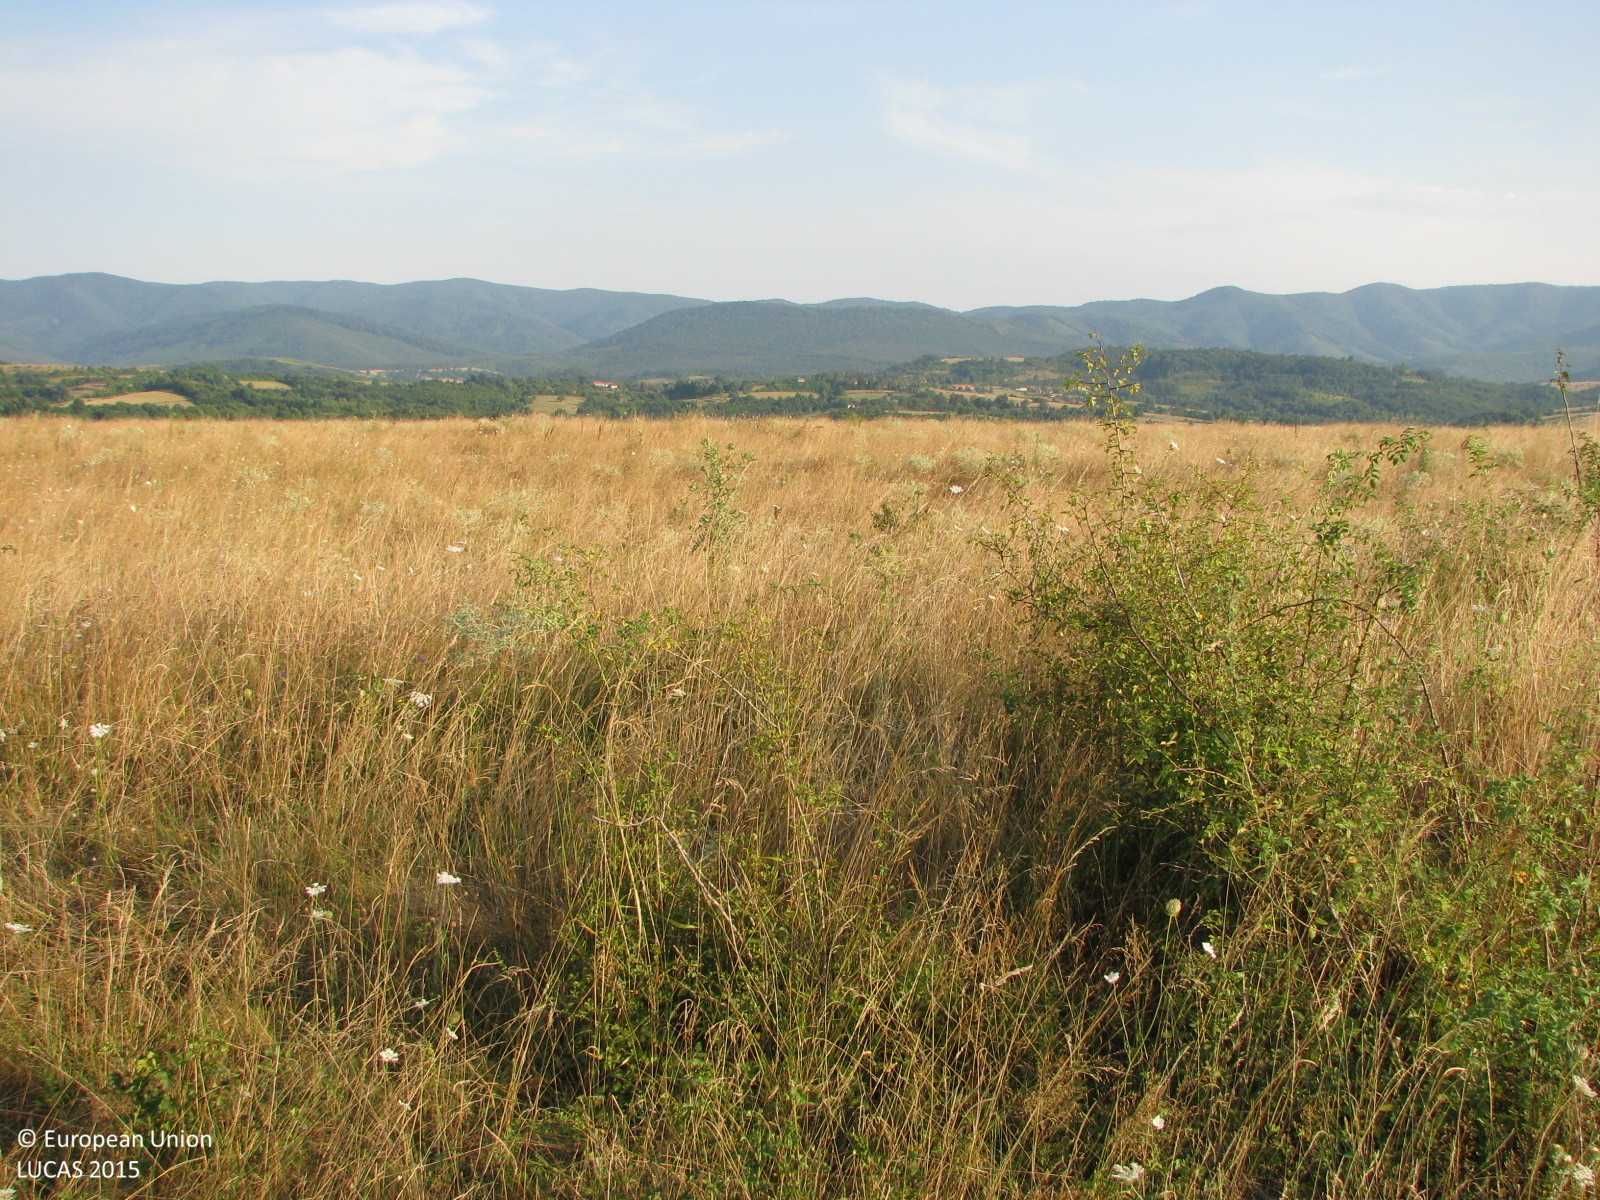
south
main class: Grassland
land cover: Grassland without tree/shrub cover
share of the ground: > 75 %
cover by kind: herbaceous plants 100 %
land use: Agriculture (excluding fallow land and kitchen gardens)
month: August
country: BG
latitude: 42.8929
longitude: 26.1427
